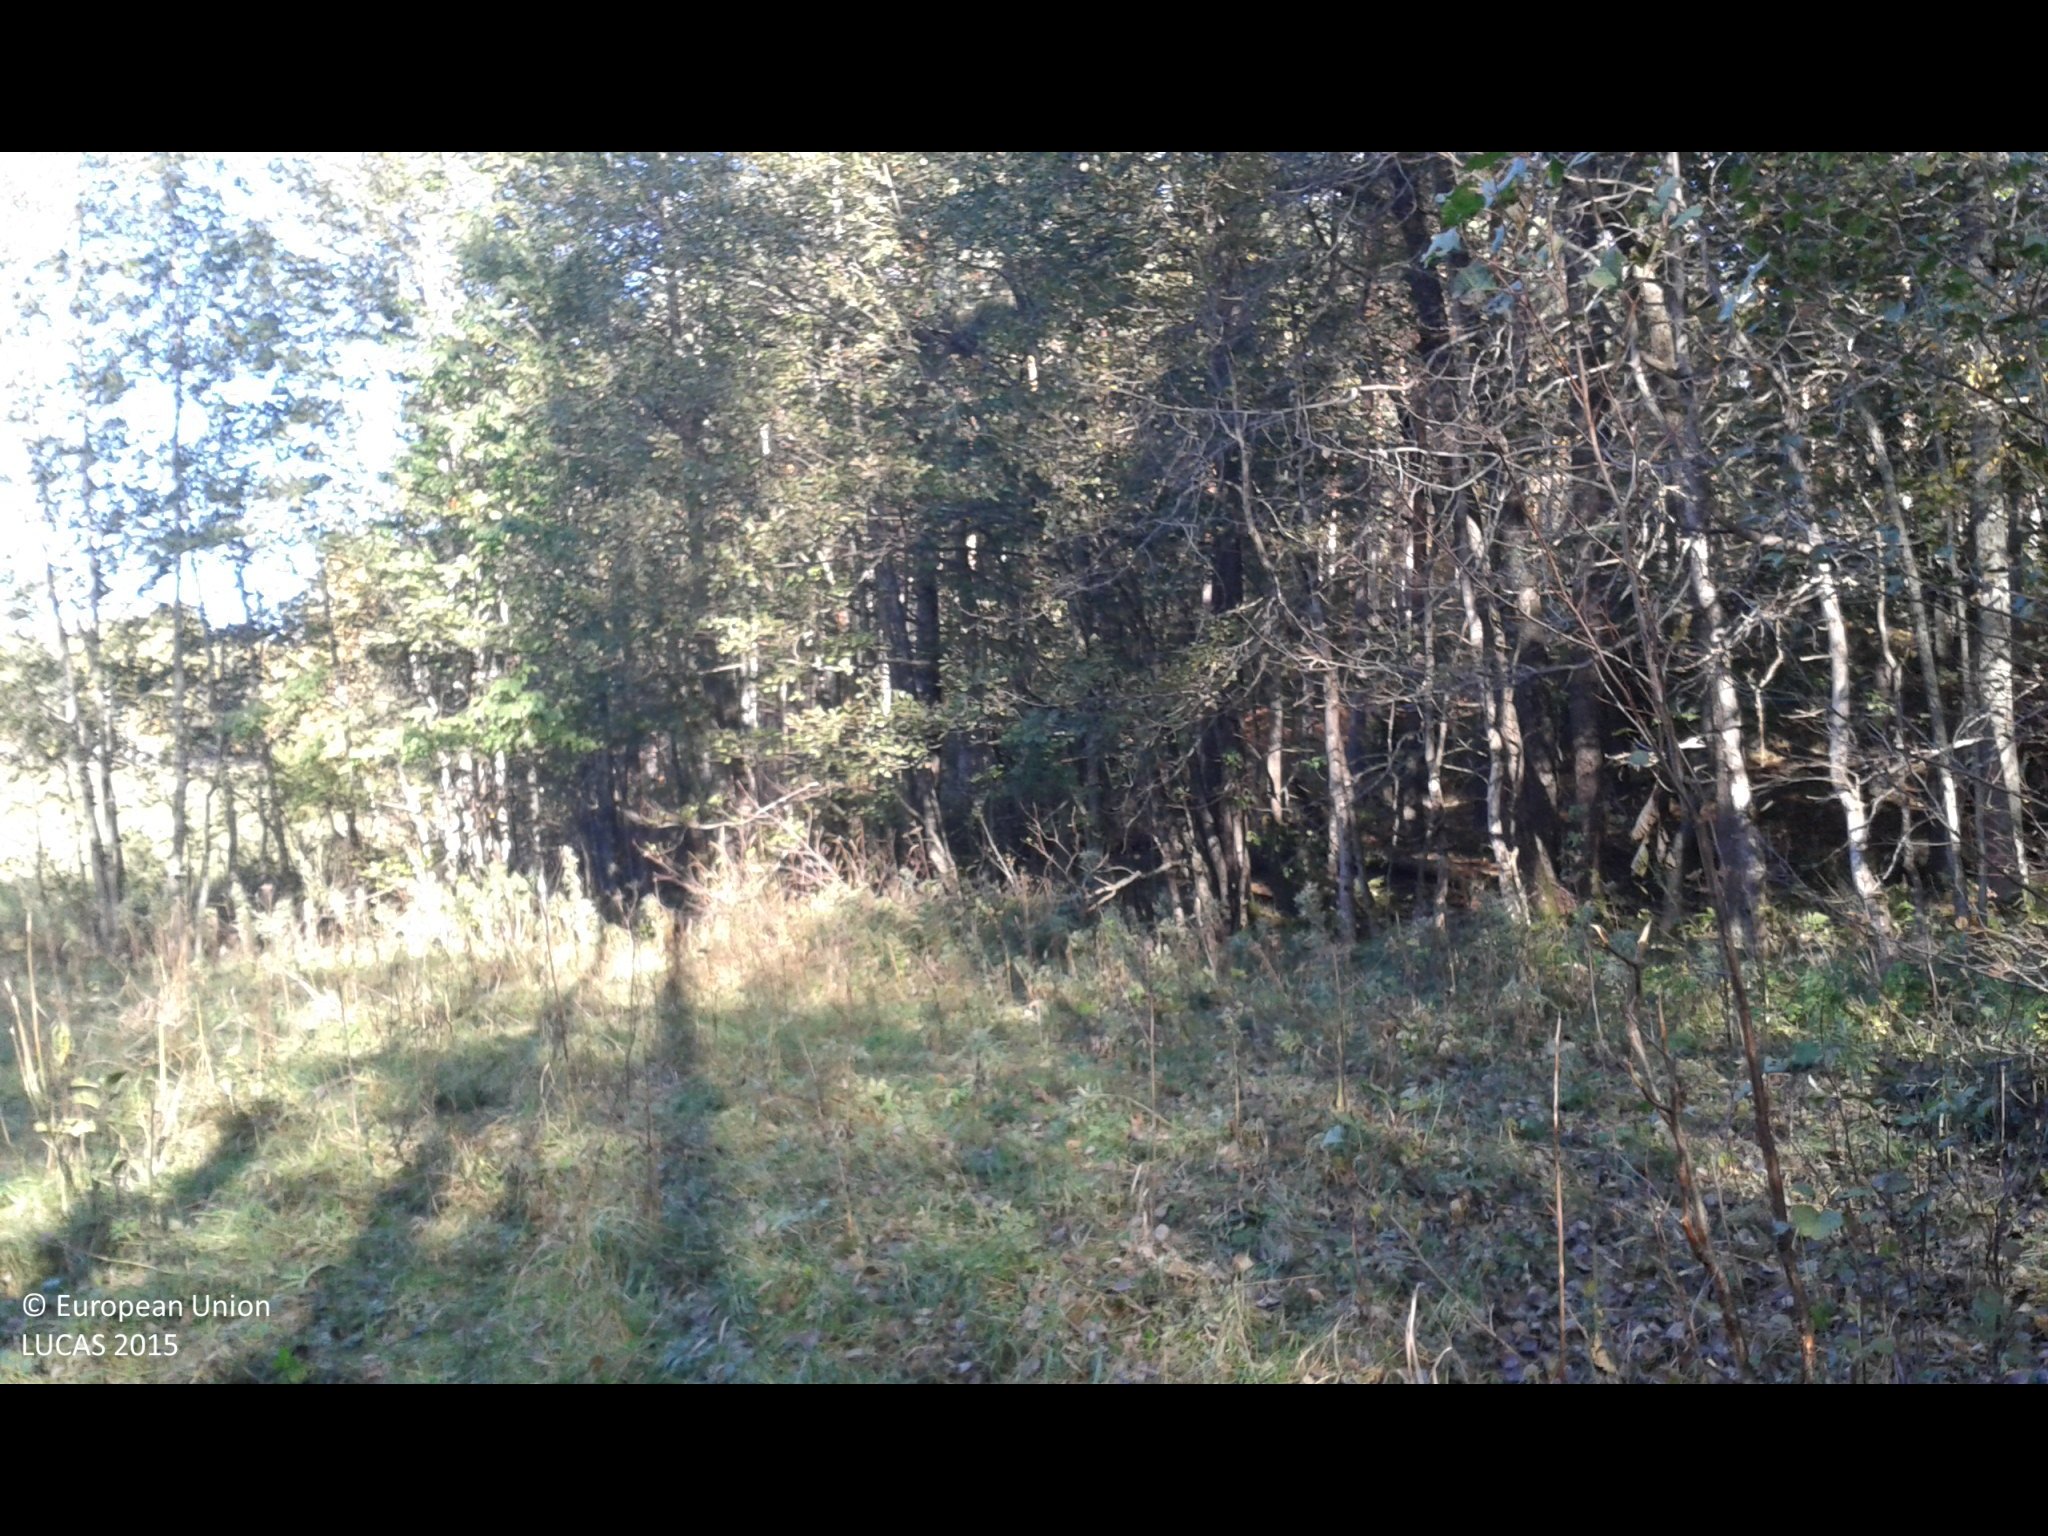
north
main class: Woodland
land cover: Pine dominated mixed woodland
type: boreal forest
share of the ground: 50 - 75 %
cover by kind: coniferous forest trees 40 %, broadleaved forest trees 30 %, shrubs 30 %
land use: Forestry
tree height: > 5 m
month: October
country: SE
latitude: 58.8188
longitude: 17.2529
